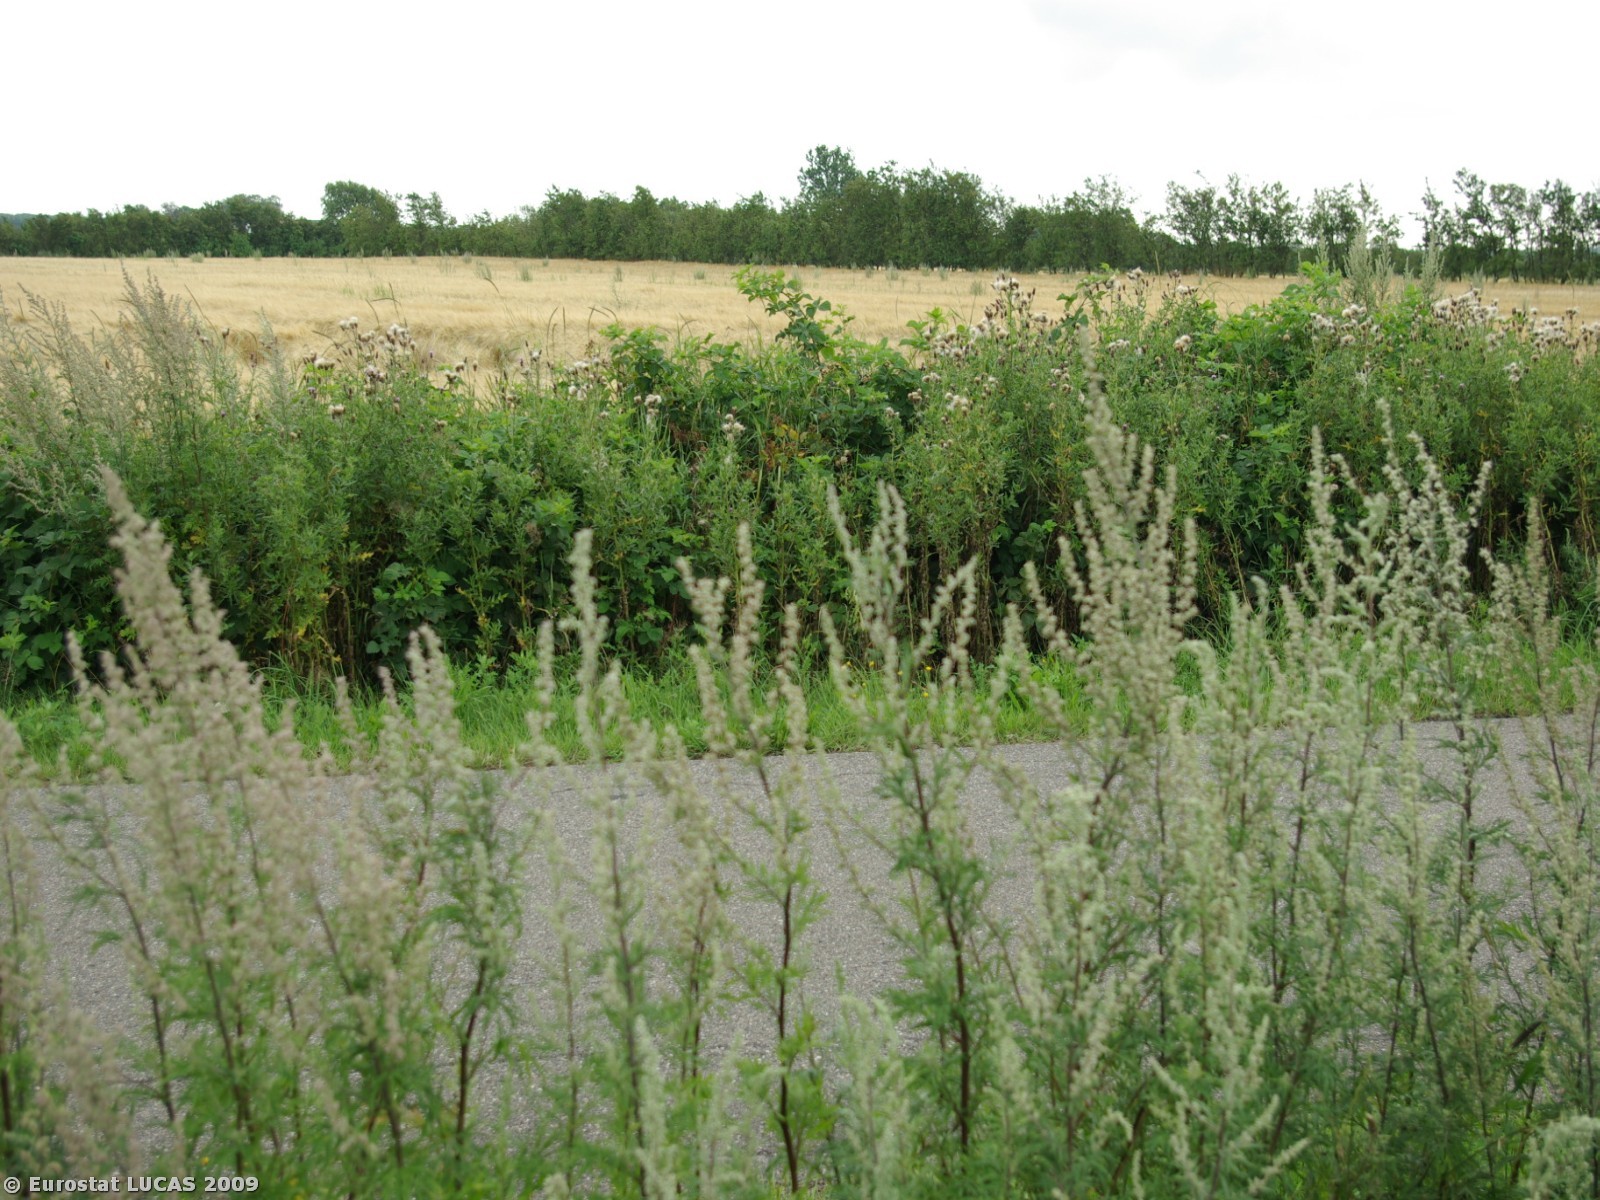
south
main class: Cropland
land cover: Maize
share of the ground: > 75 %
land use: Agriculture (excluding fallow land and kitchen gardens)
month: July
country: DK
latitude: 55.2125
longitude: 8.9165
